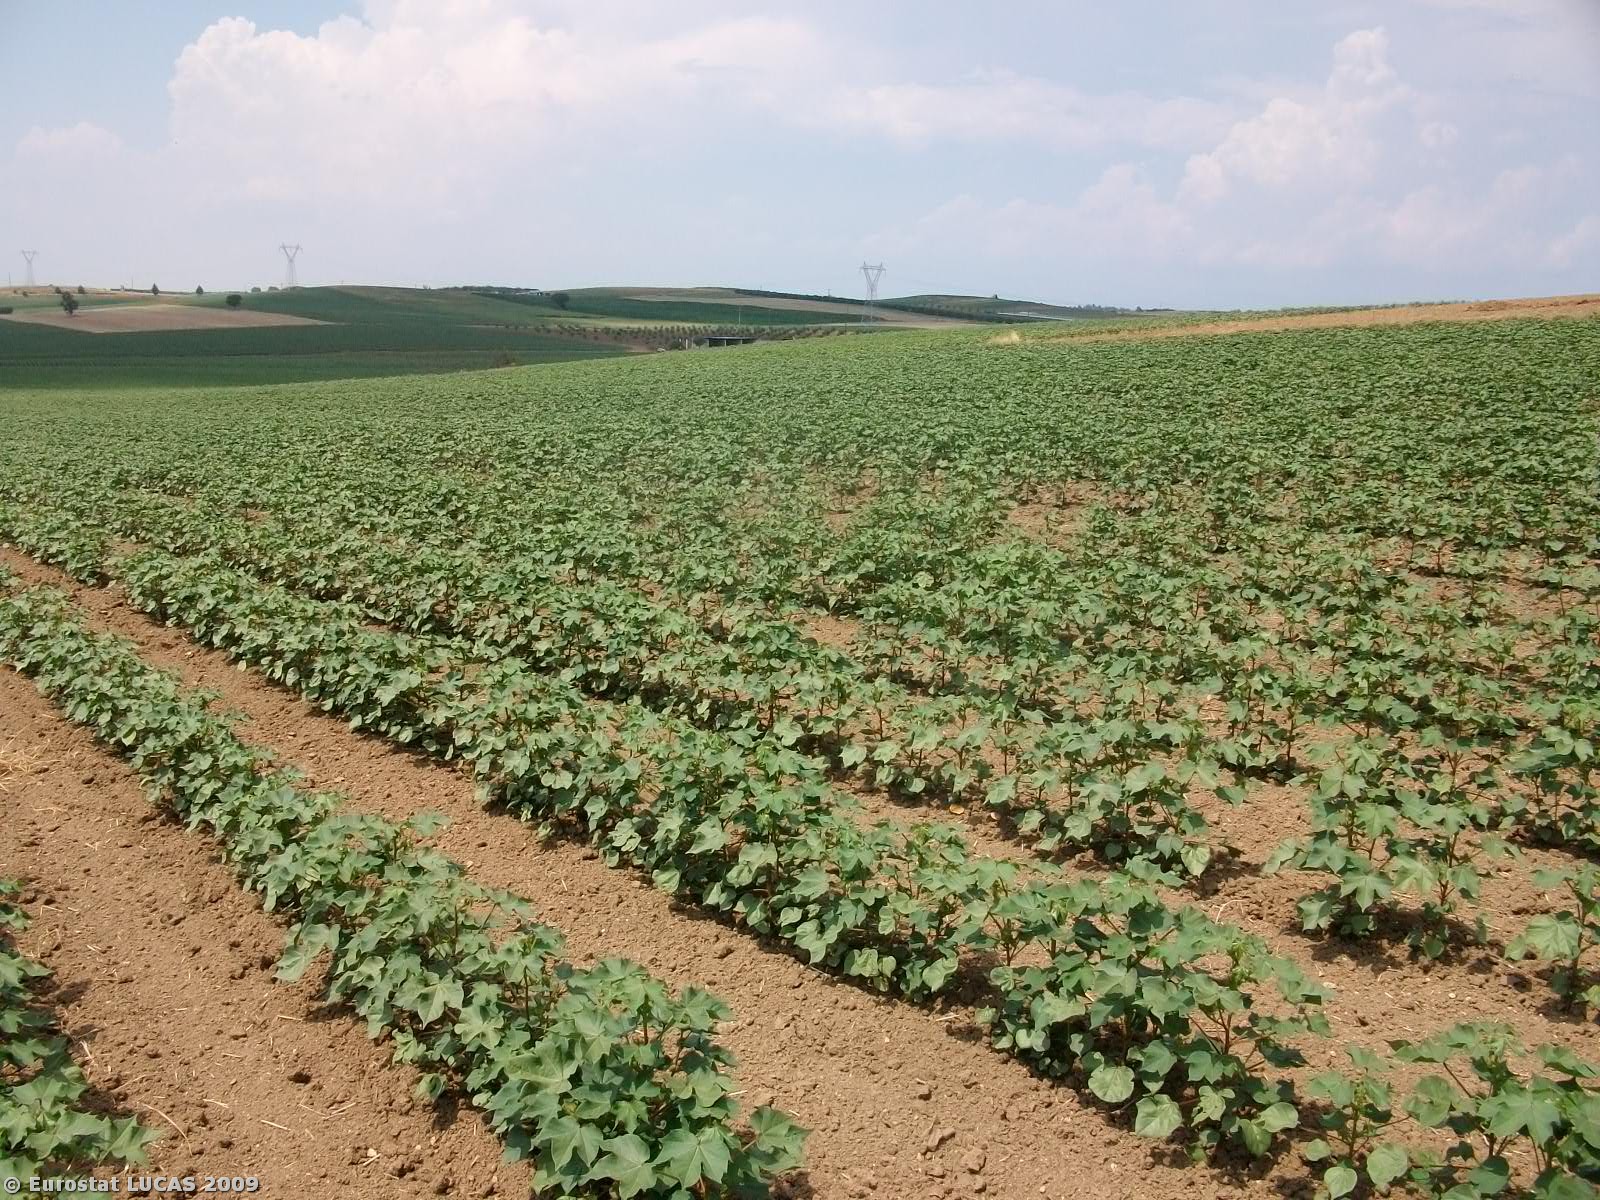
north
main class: Cropland
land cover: Cotton
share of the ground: 25 - 50 %
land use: Agriculture (excluding fallow land and kitchen gardens)
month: July
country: GR
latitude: 40.1167
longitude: 23.3701
